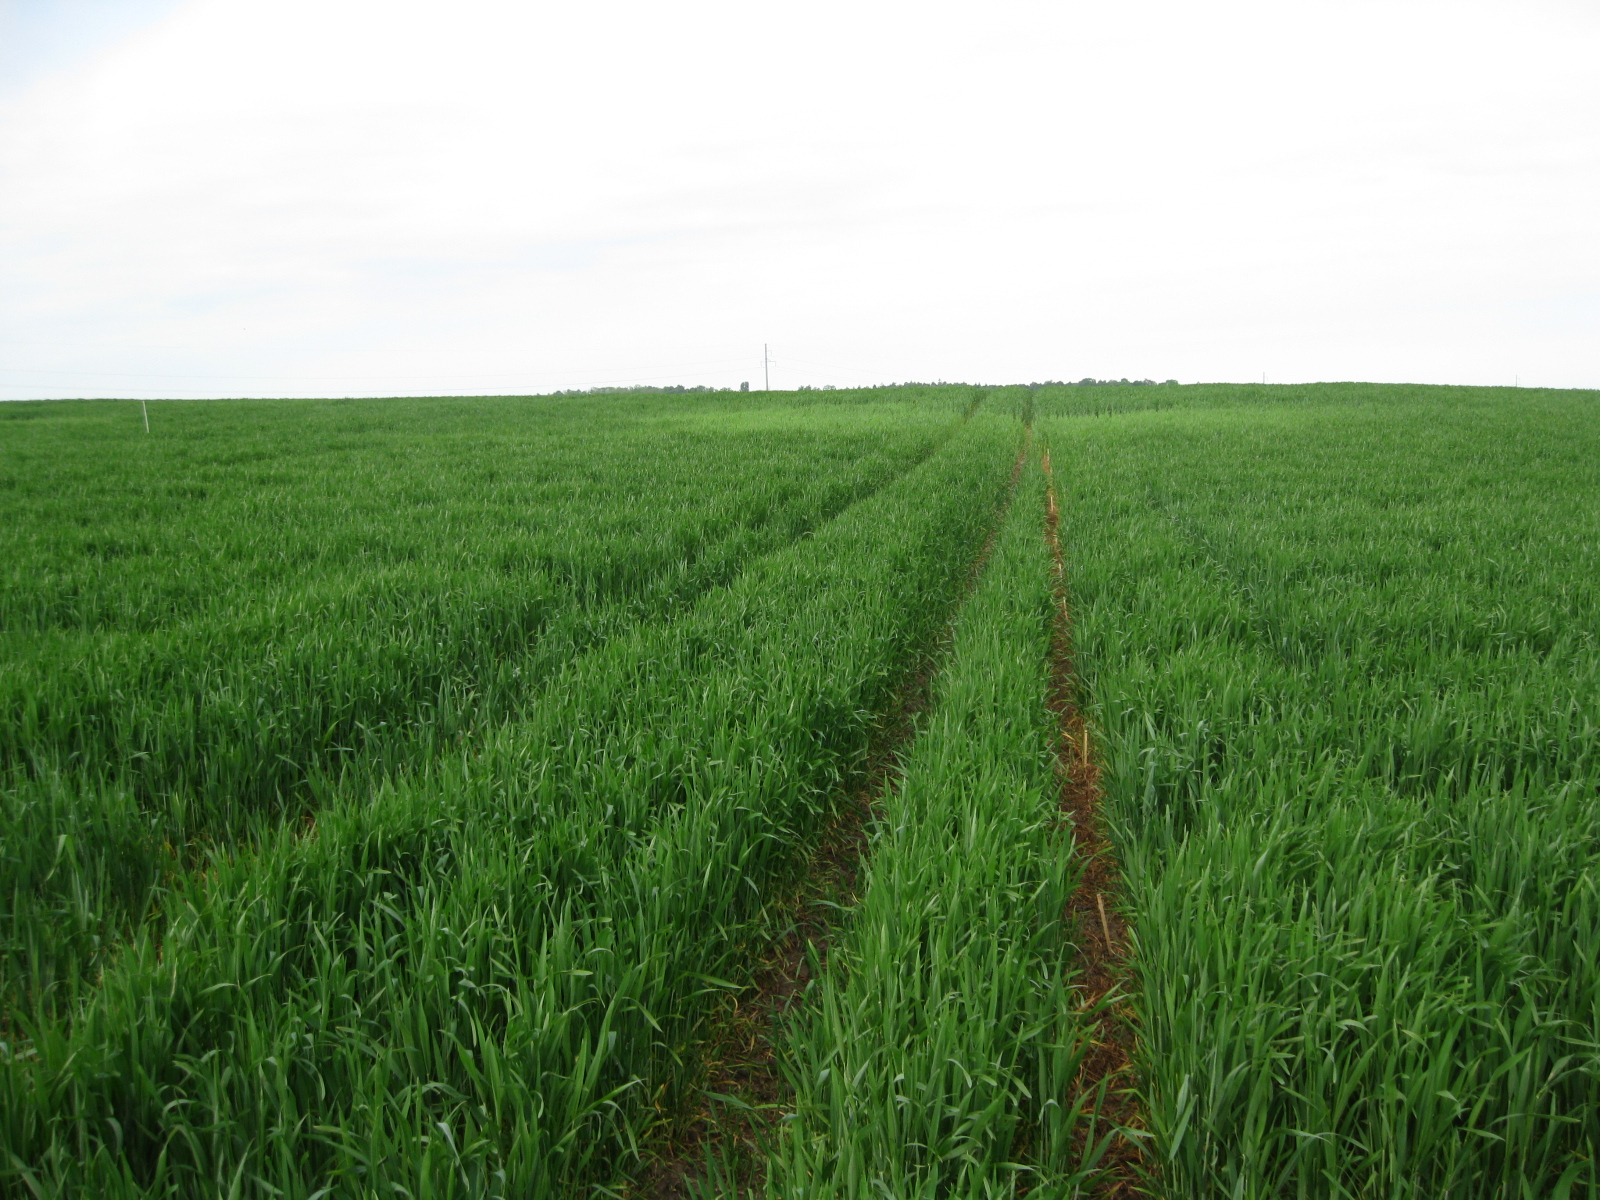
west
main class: Cropland
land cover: Barley
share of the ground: > 75 %
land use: Agriculture (excluding fallow land and kitchen gardens)
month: June
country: LT
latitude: 55.7614
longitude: 23.6754
